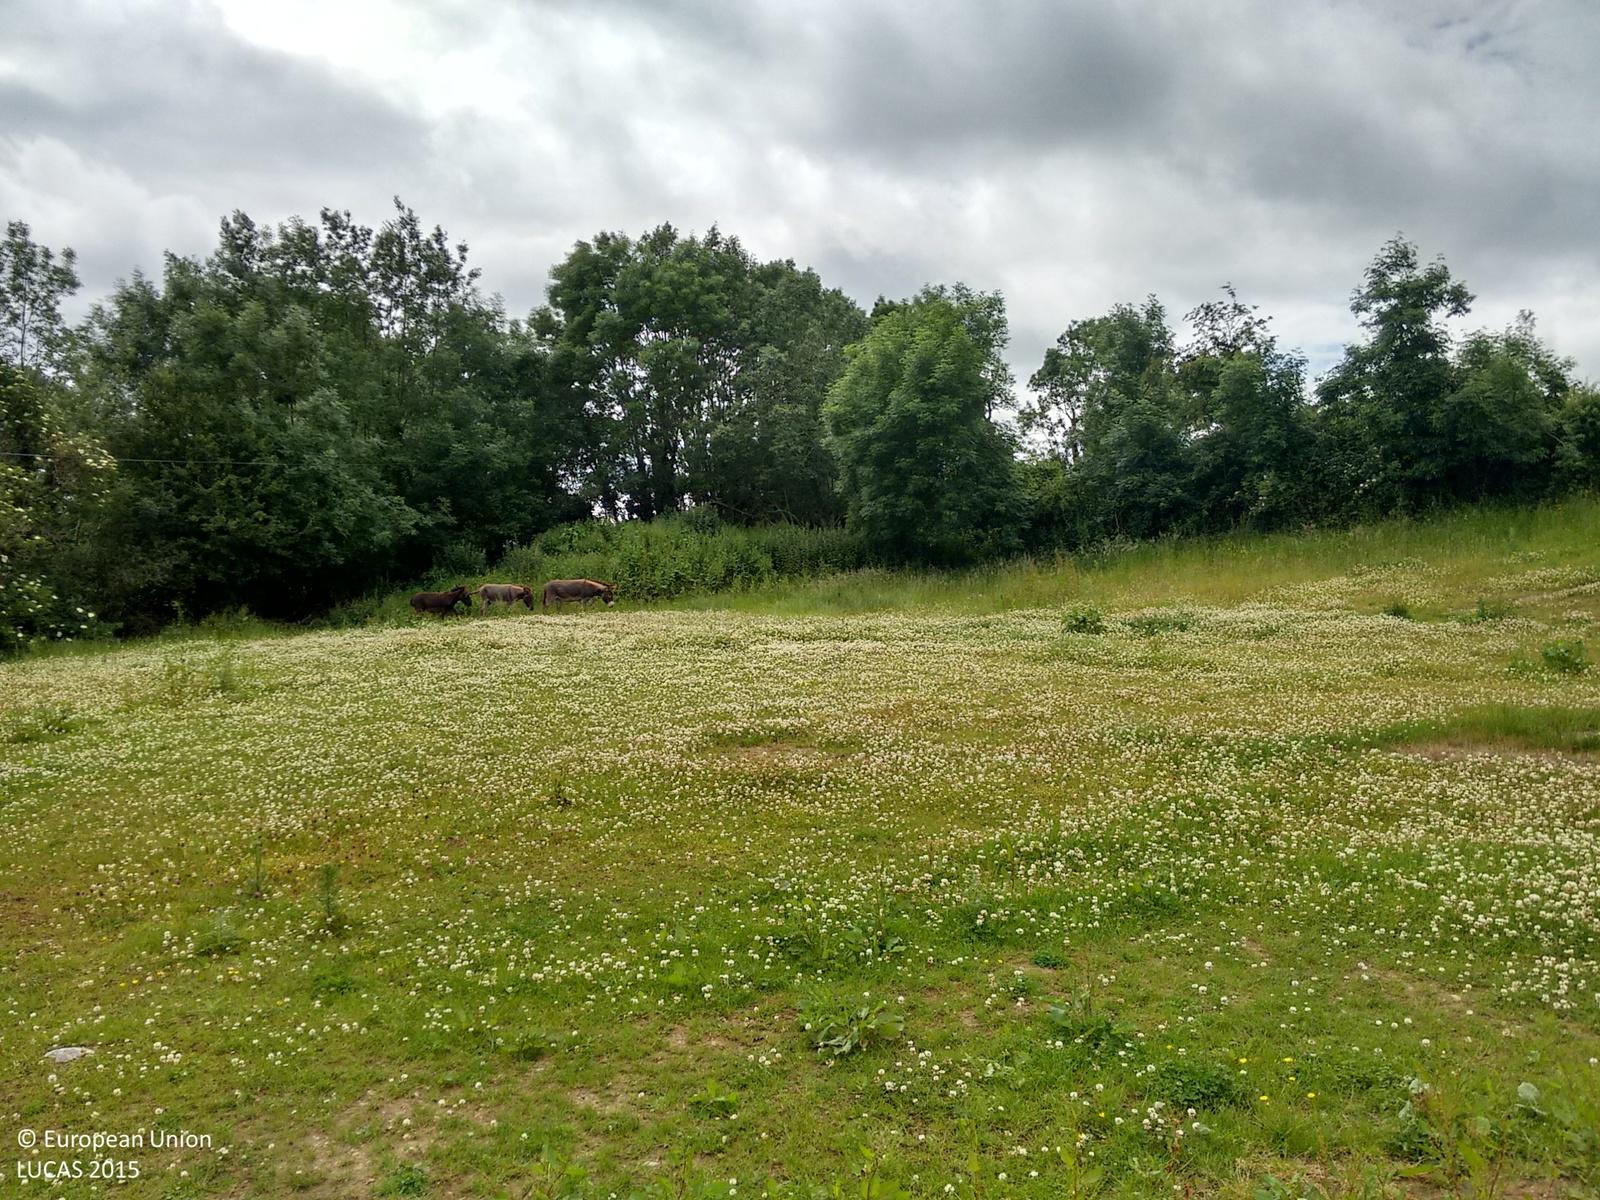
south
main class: Grassland
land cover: Grassland without tree/shrub cover
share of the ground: > 75 %
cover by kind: herbaceous plants 100 %
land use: Agriculture (excluding fallow land and kitchen gardens)
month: June
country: IE
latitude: 53.4368
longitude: -8.0136
